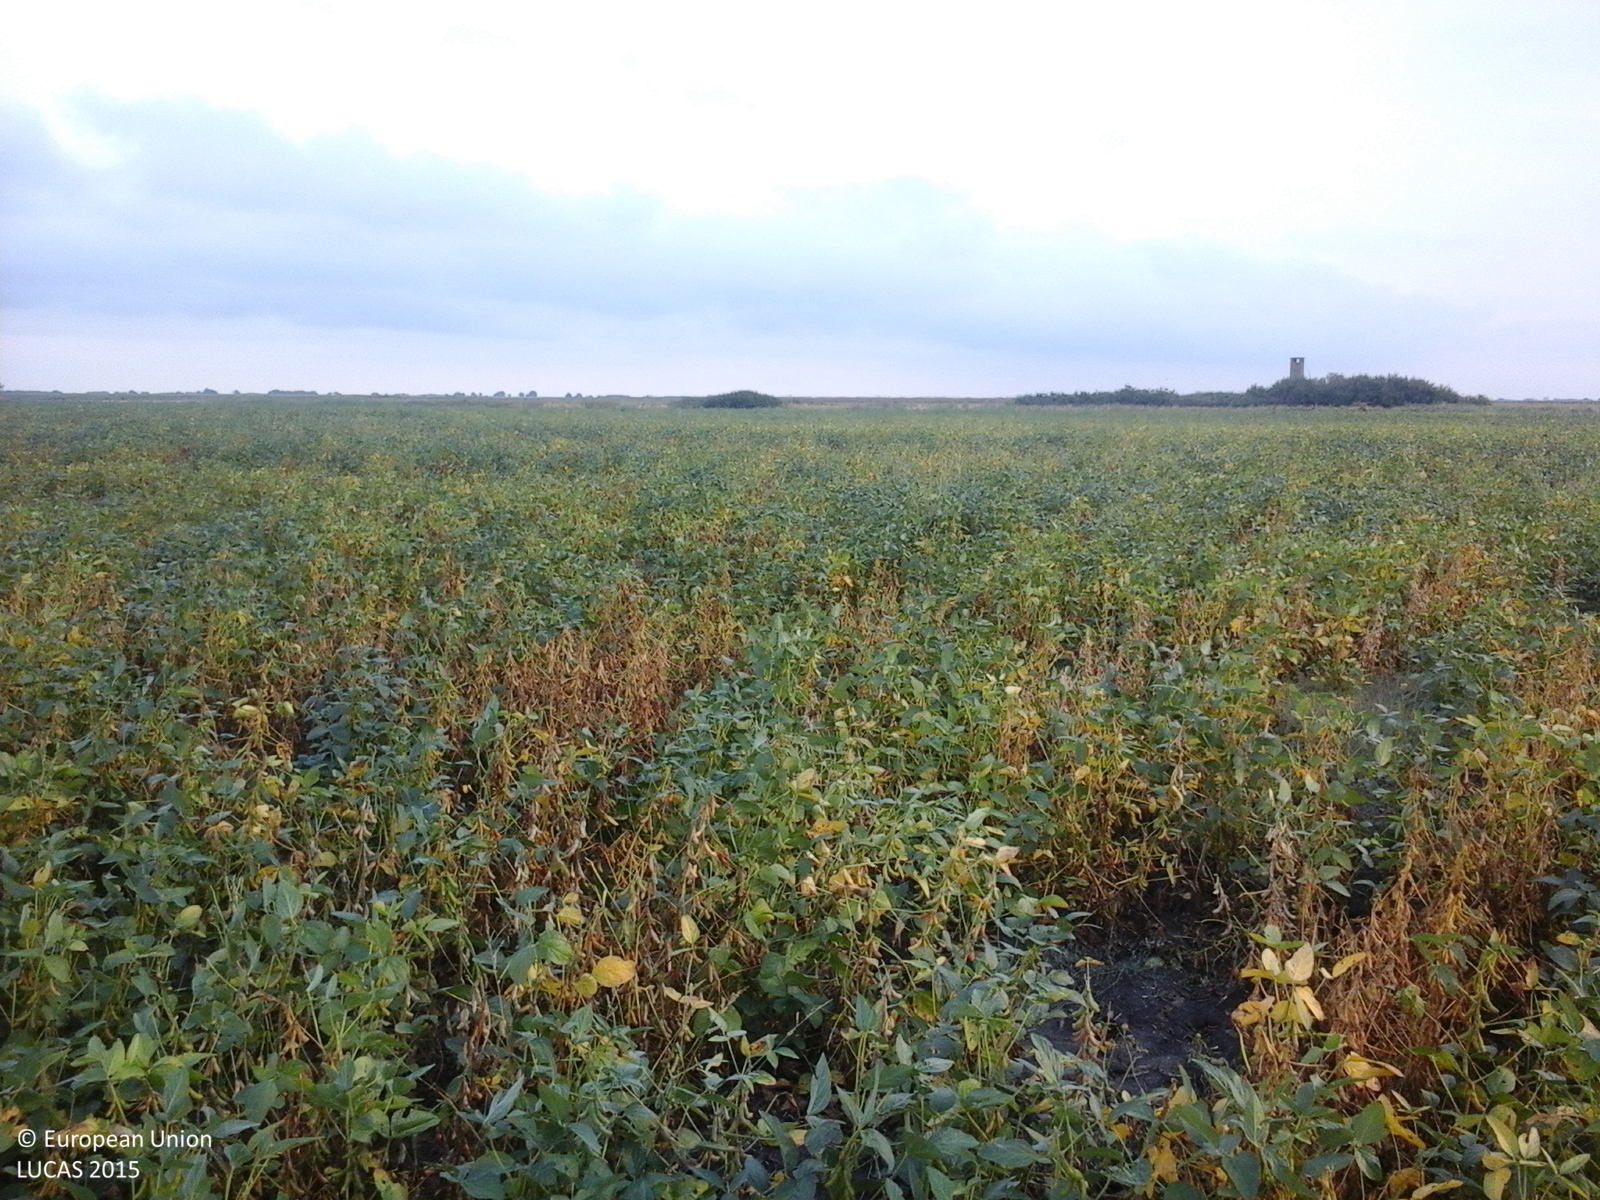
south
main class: Cropland
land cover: Soya
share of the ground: > 75 %
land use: Agriculture (excluding fallow land and kitchen gardens)
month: August
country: RO
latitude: 45.9637
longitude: 20.4629
